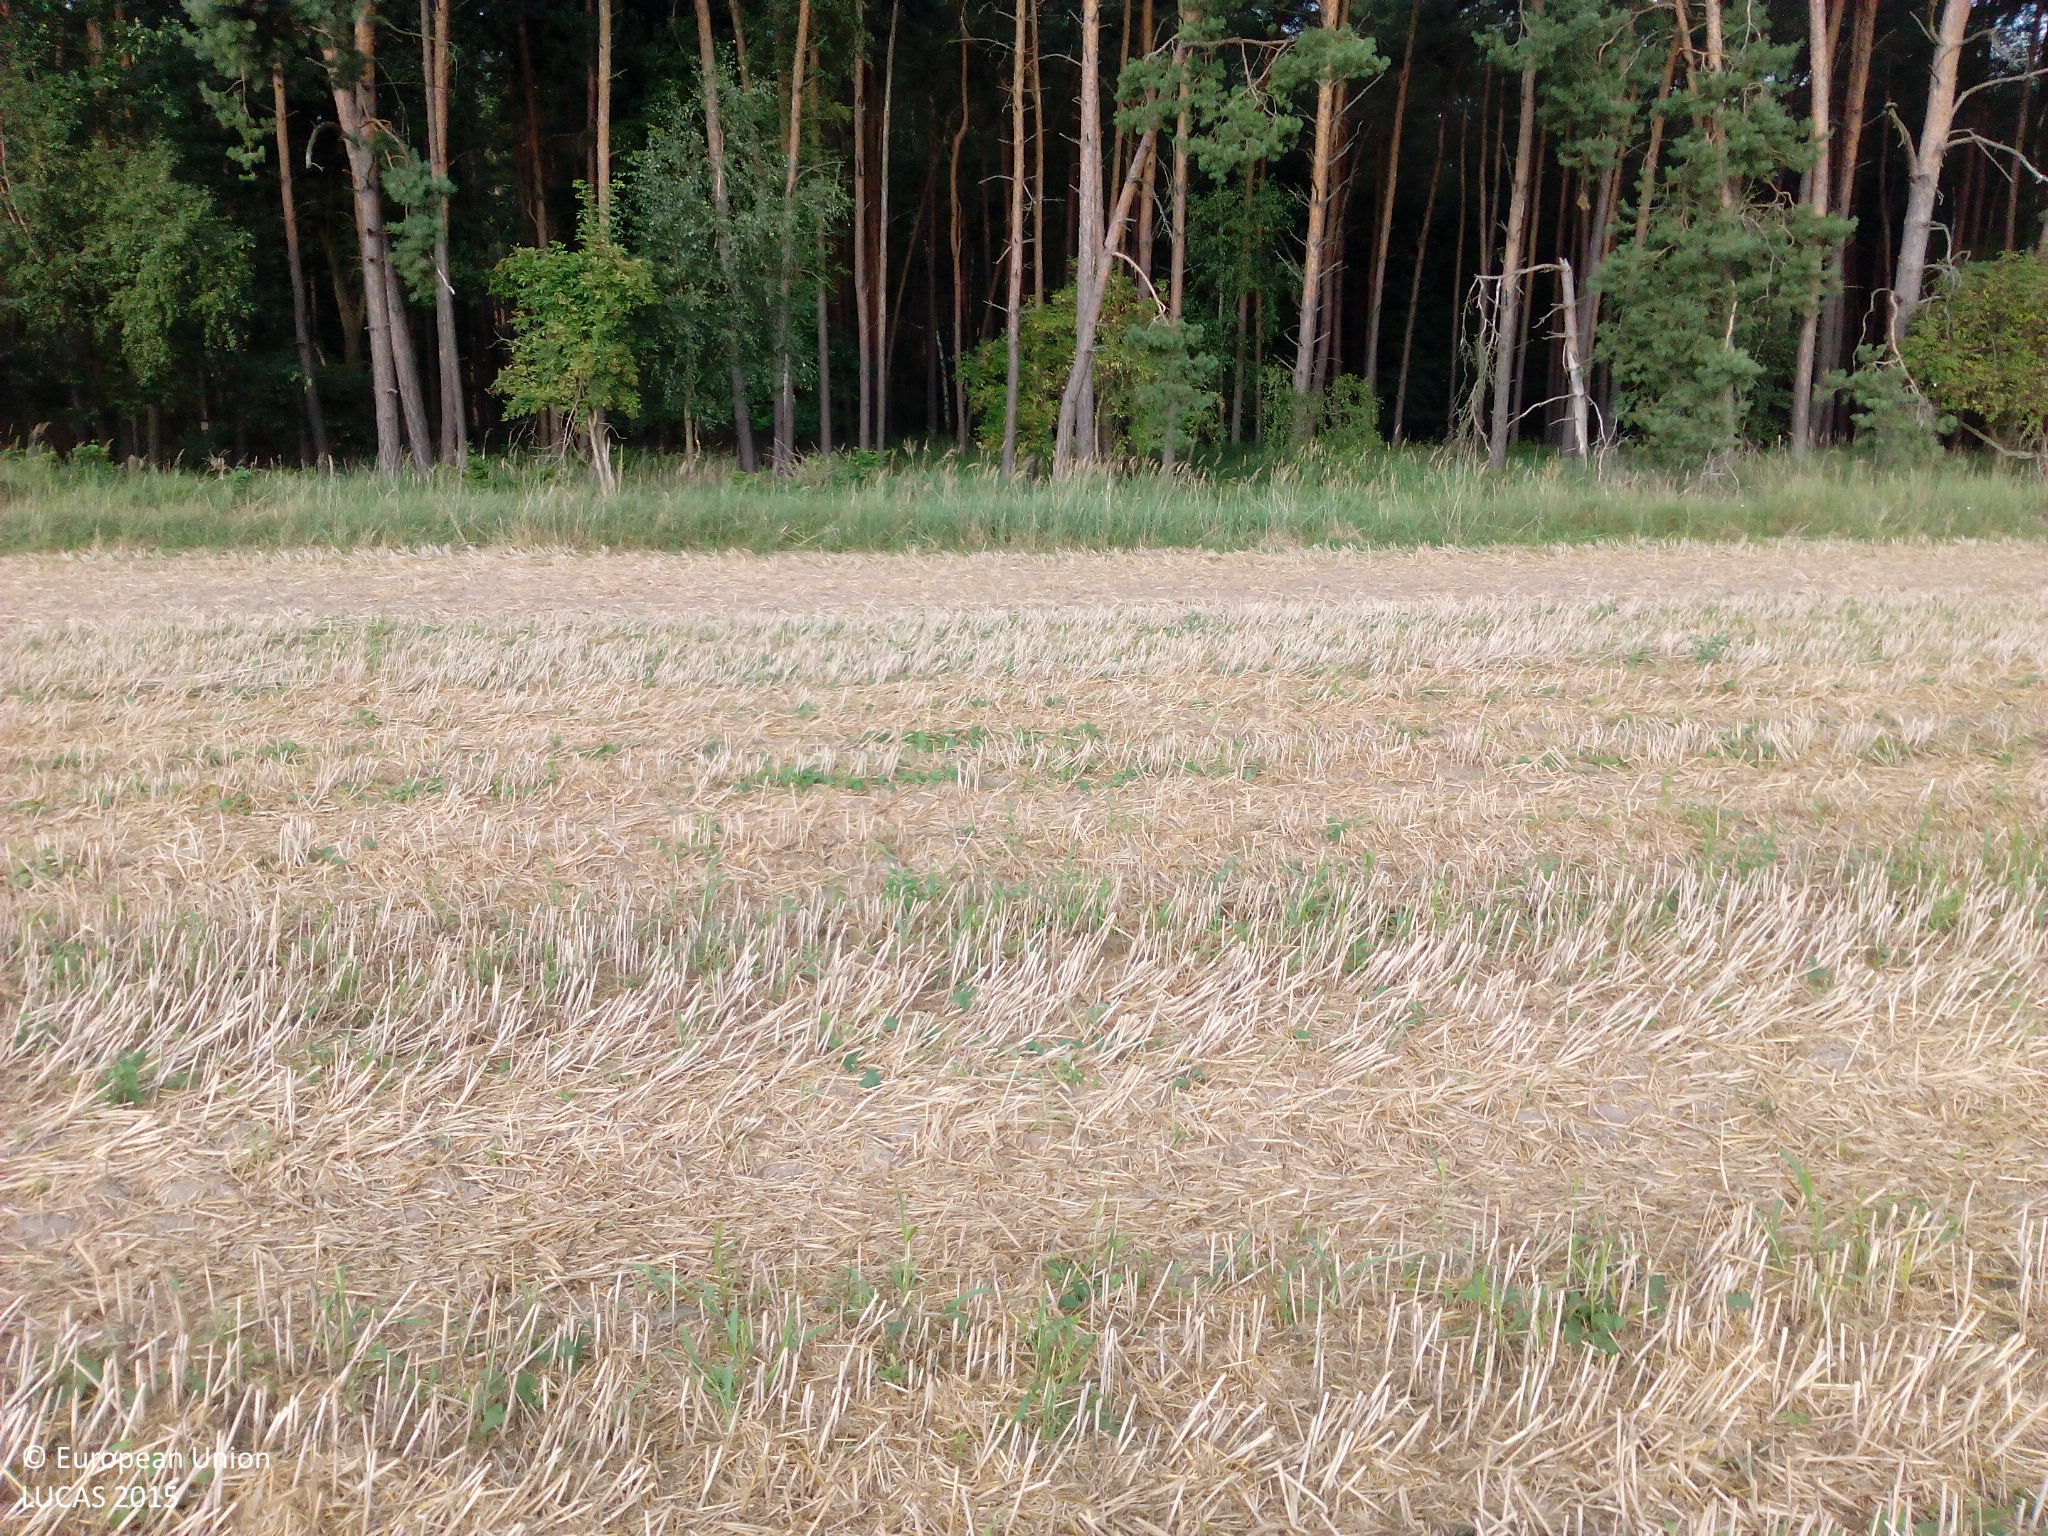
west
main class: Cropland
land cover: Rye
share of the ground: 25 - 50 %
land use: Agriculture (excluding fallow land and kitchen gardens)
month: August
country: DE
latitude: 51.8500
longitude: 13.1503
